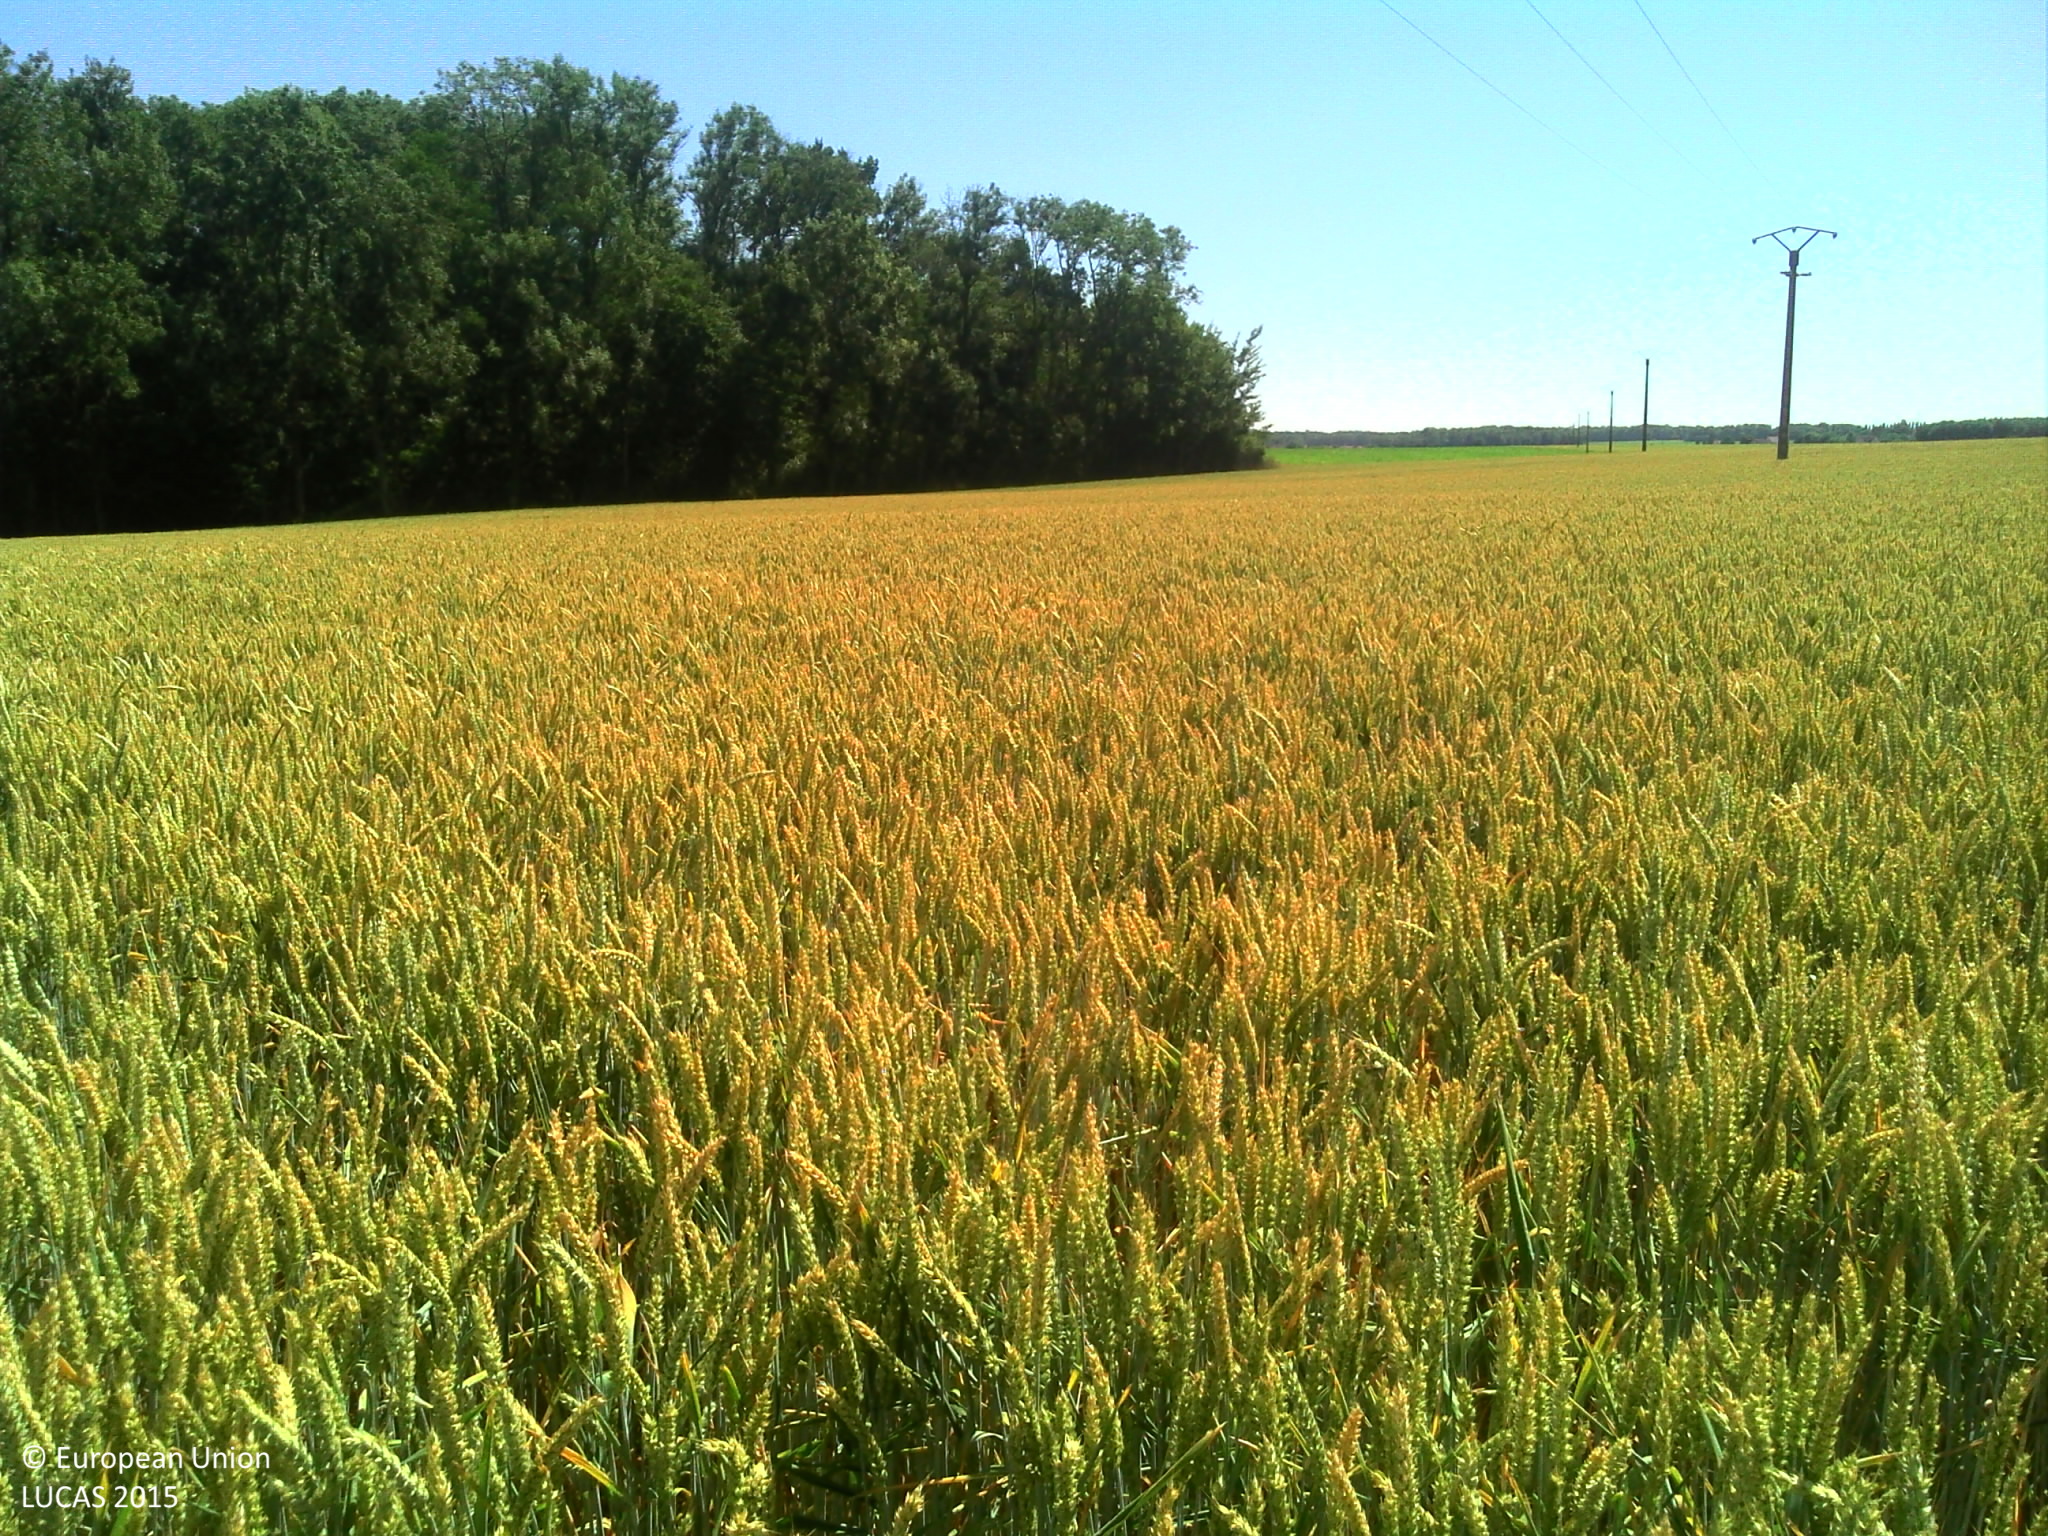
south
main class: Cropland
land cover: Common wheat
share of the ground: > 75 %
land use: Agriculture (excluding fallow land and kitchen gardens)
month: June
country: FR
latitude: 48.9641
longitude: 3.3956
